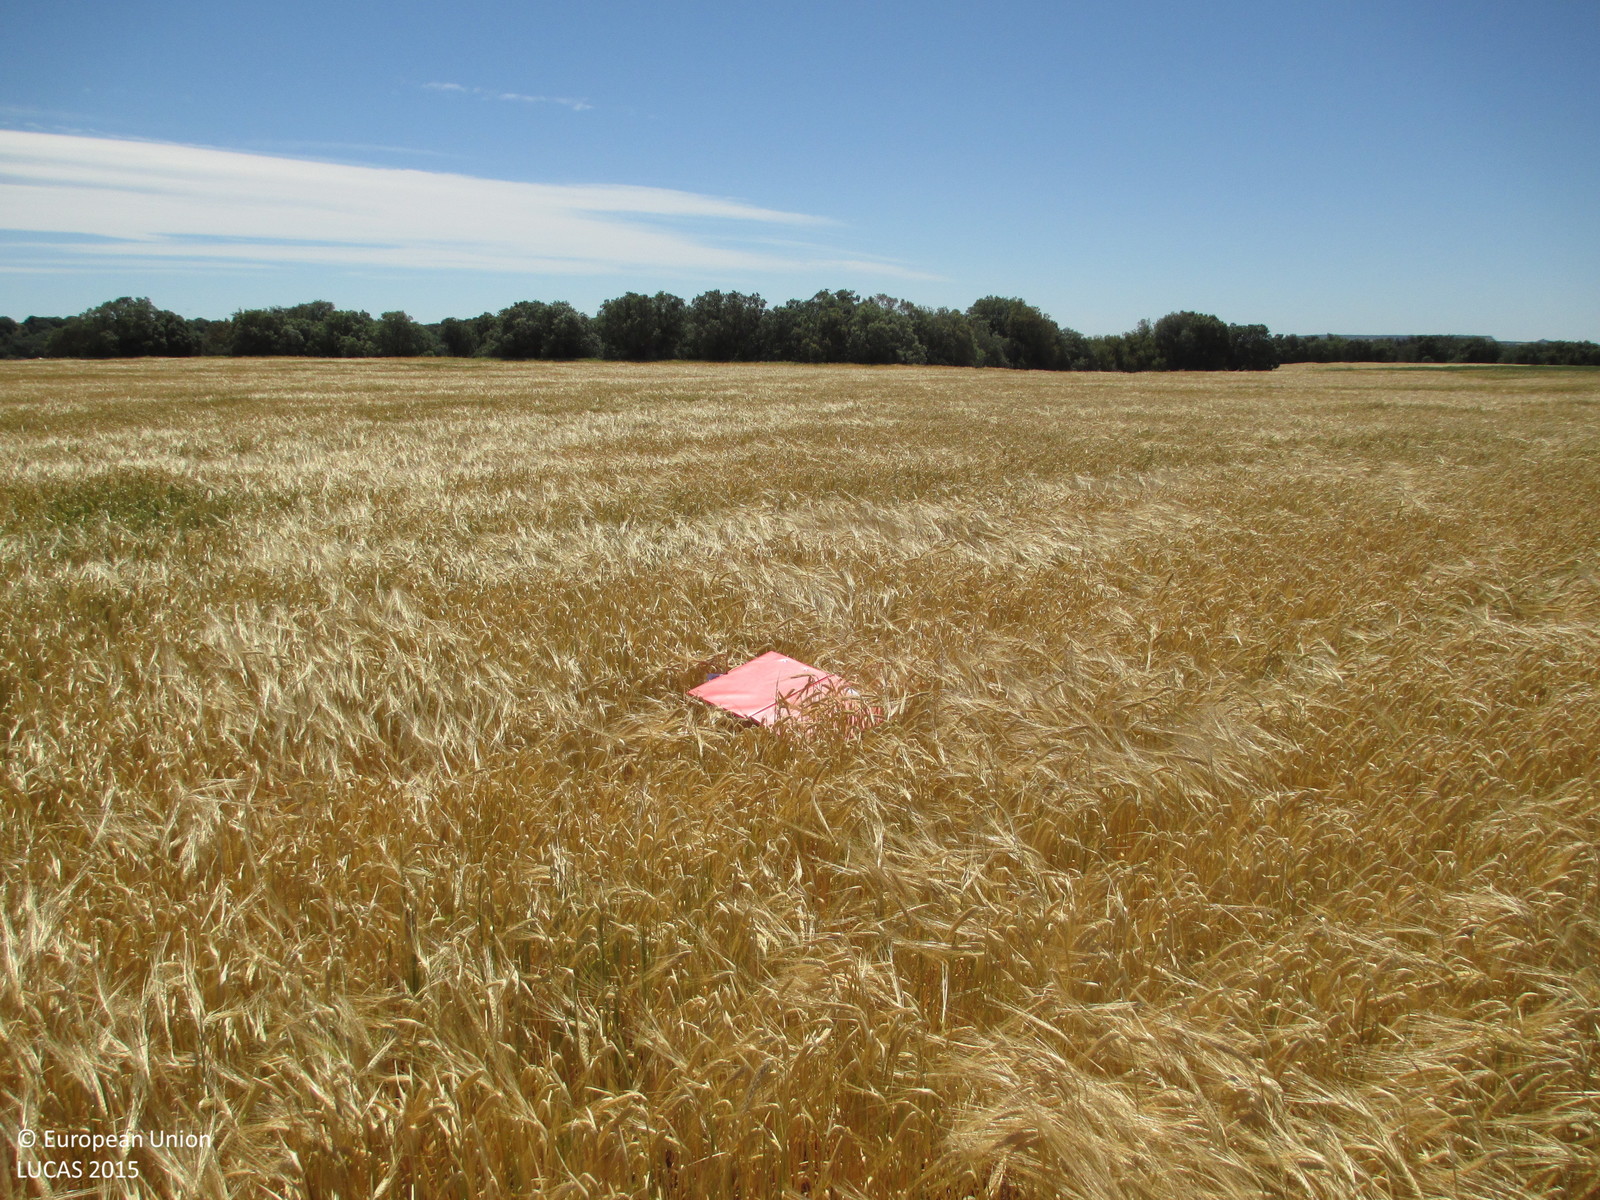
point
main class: Cropland
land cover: Barley
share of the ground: > 75 %
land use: Agriculture (excluding fallow land and kitchen gardens)
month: May
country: ES
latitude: 42.0235
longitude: -0.2499
